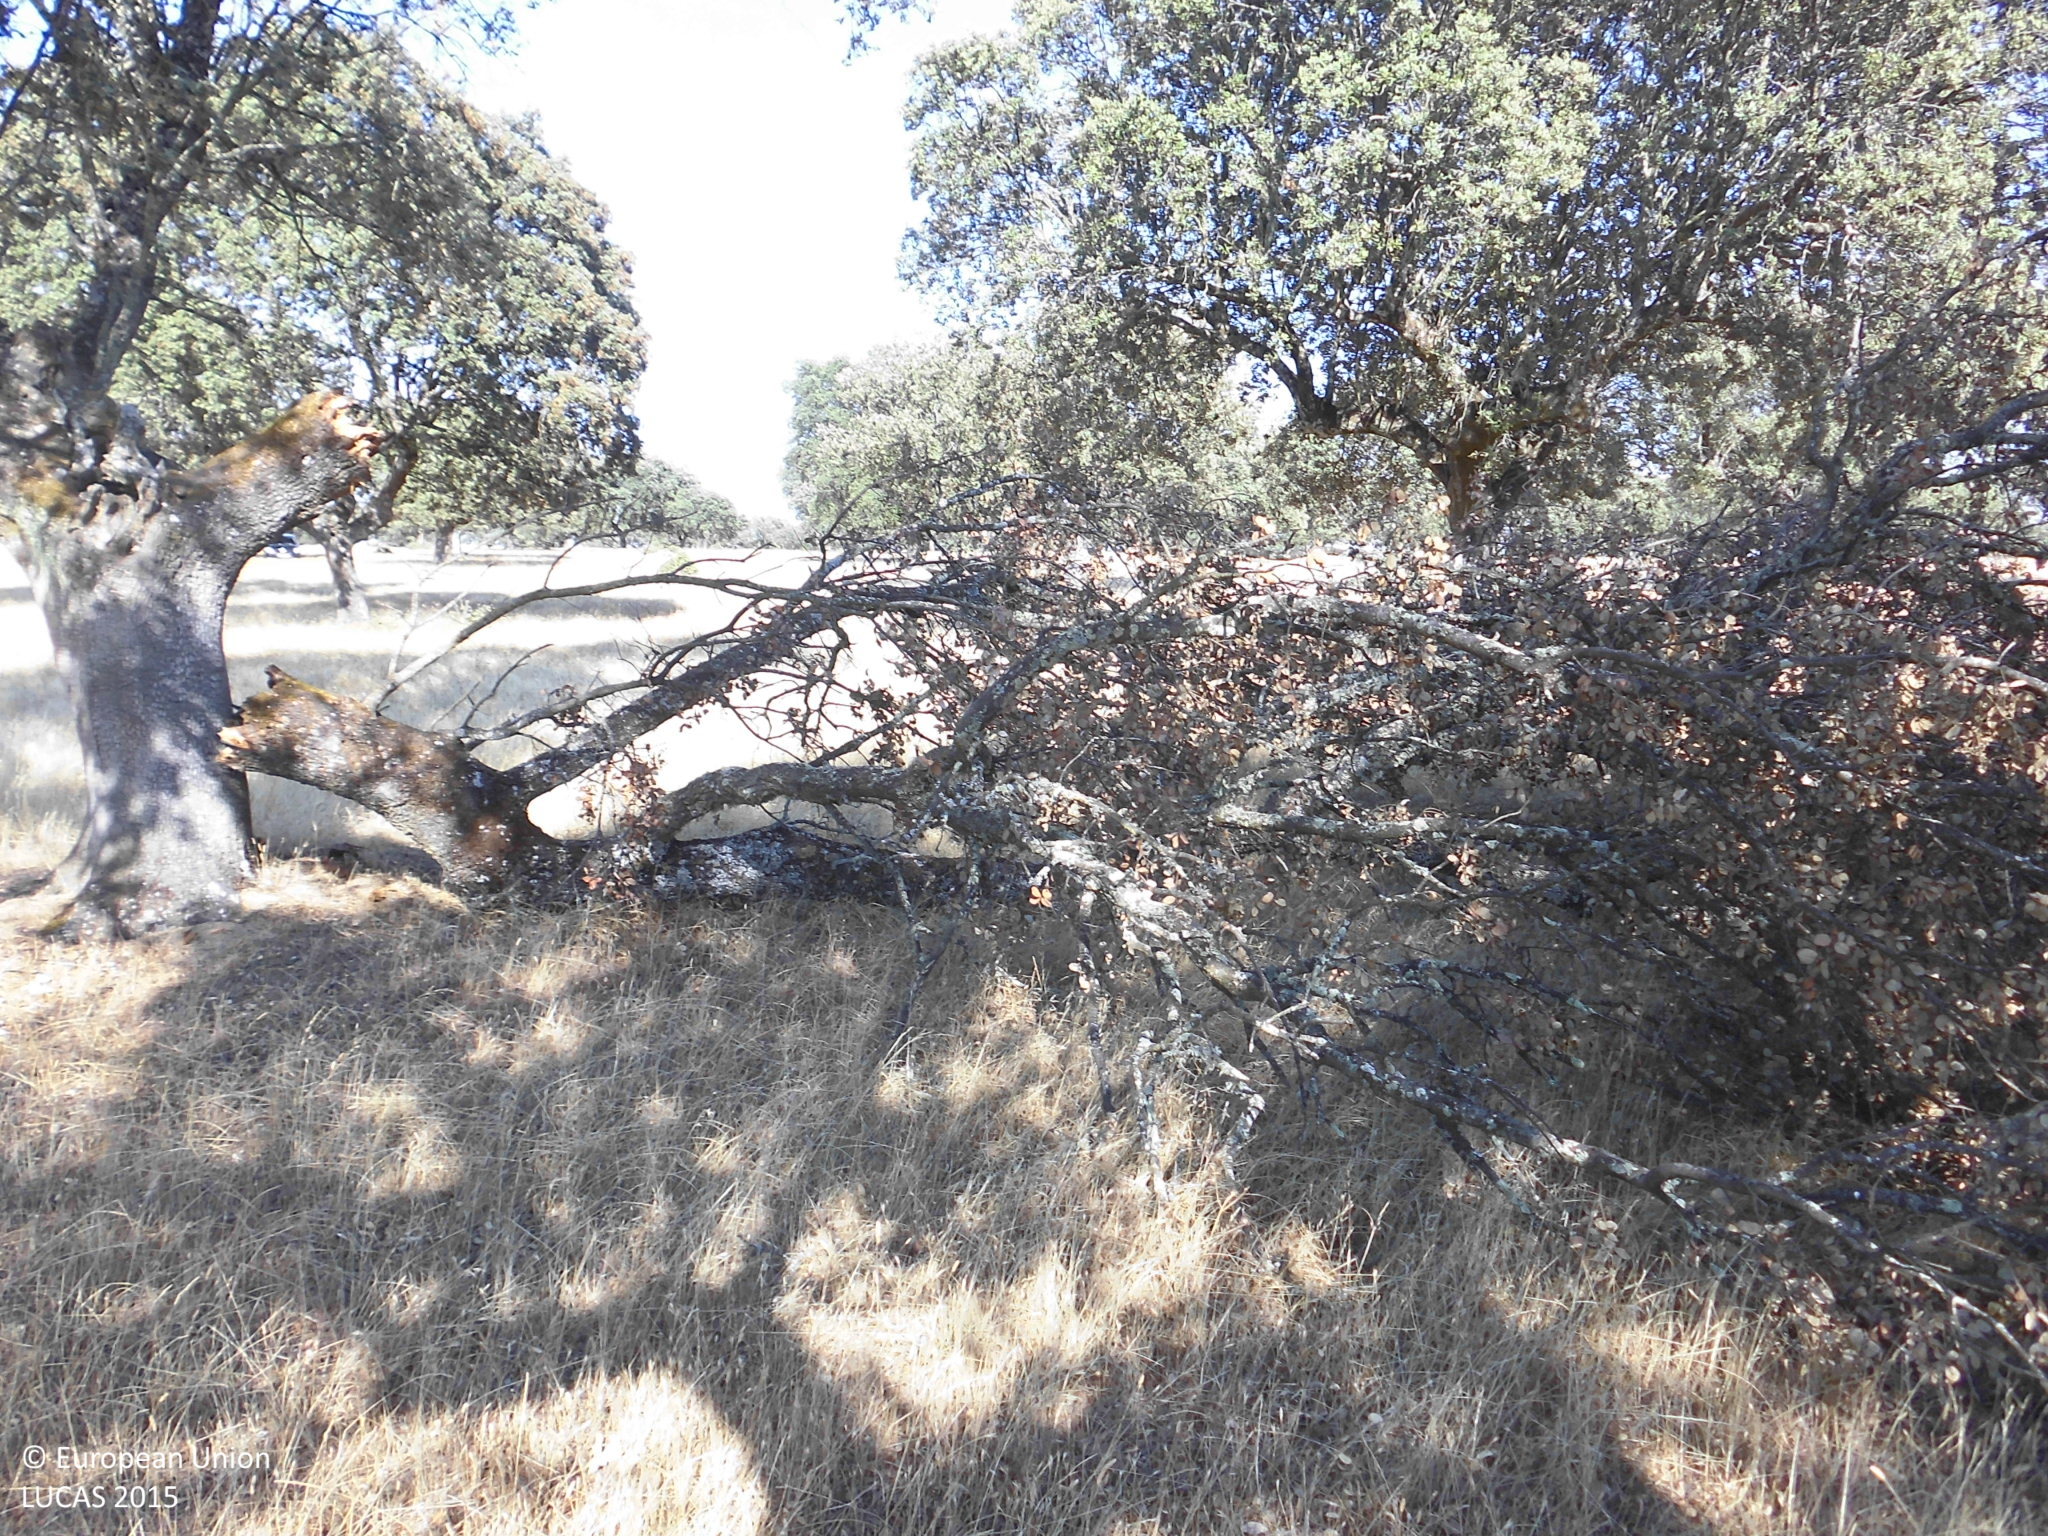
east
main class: Woodland
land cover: Broadleaved woodland
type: broadleaved evergreen forest
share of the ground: 25 - 50 %
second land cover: Grassland without tree/shrub cover
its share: > 75 %
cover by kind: broadleaved forest trees 50 %, herbaceous plants 50 %
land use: Forestry
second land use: Agriculture (excluding fallow land and kitchen gardens)
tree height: > 5 m
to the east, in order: Broadleaved woodland; Grassland without tree/shrub cover; Broadleaved woodland
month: June
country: ES
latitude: 39.9376
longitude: -6.1148
